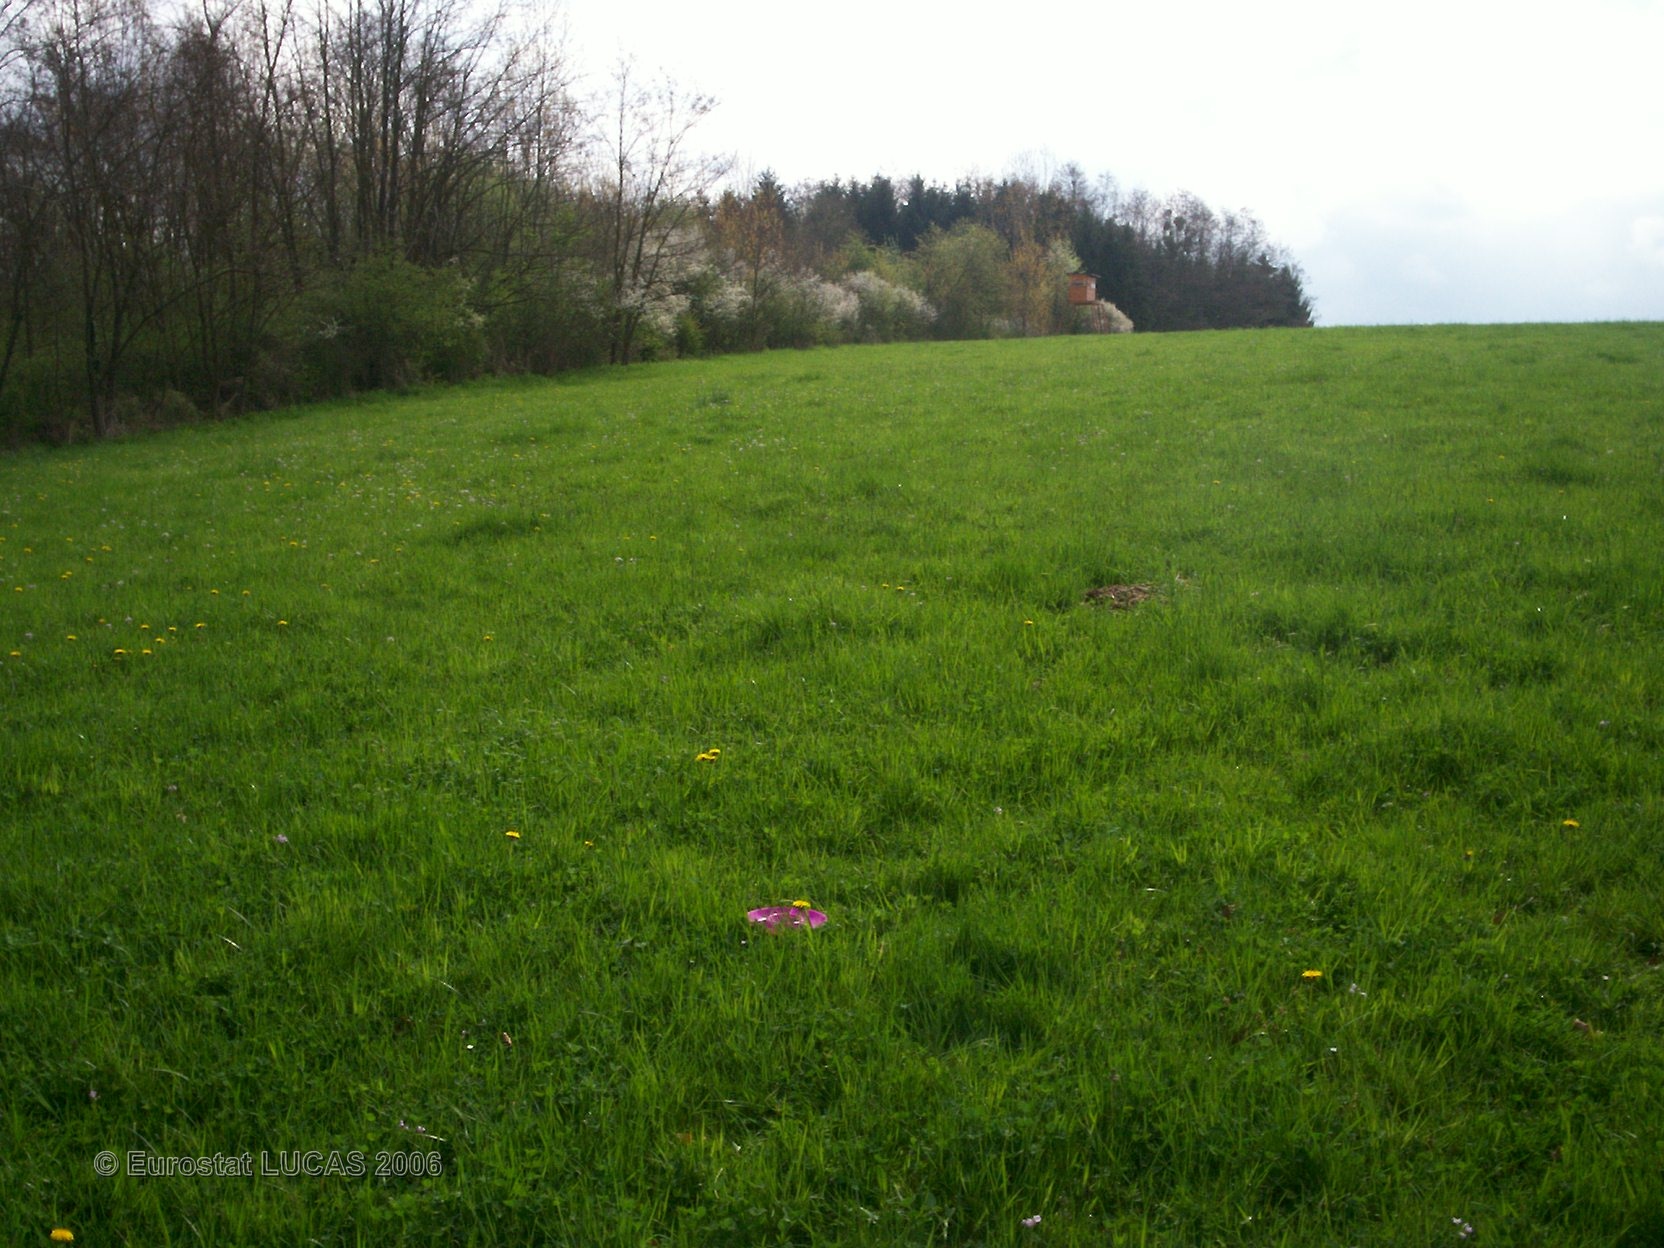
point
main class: Grassland
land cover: Grassland without tree/shrub cover
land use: Agriculture (excluding fallow land and kitchen gardens)
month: April
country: FR
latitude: 48.7878
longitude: 6.7474
